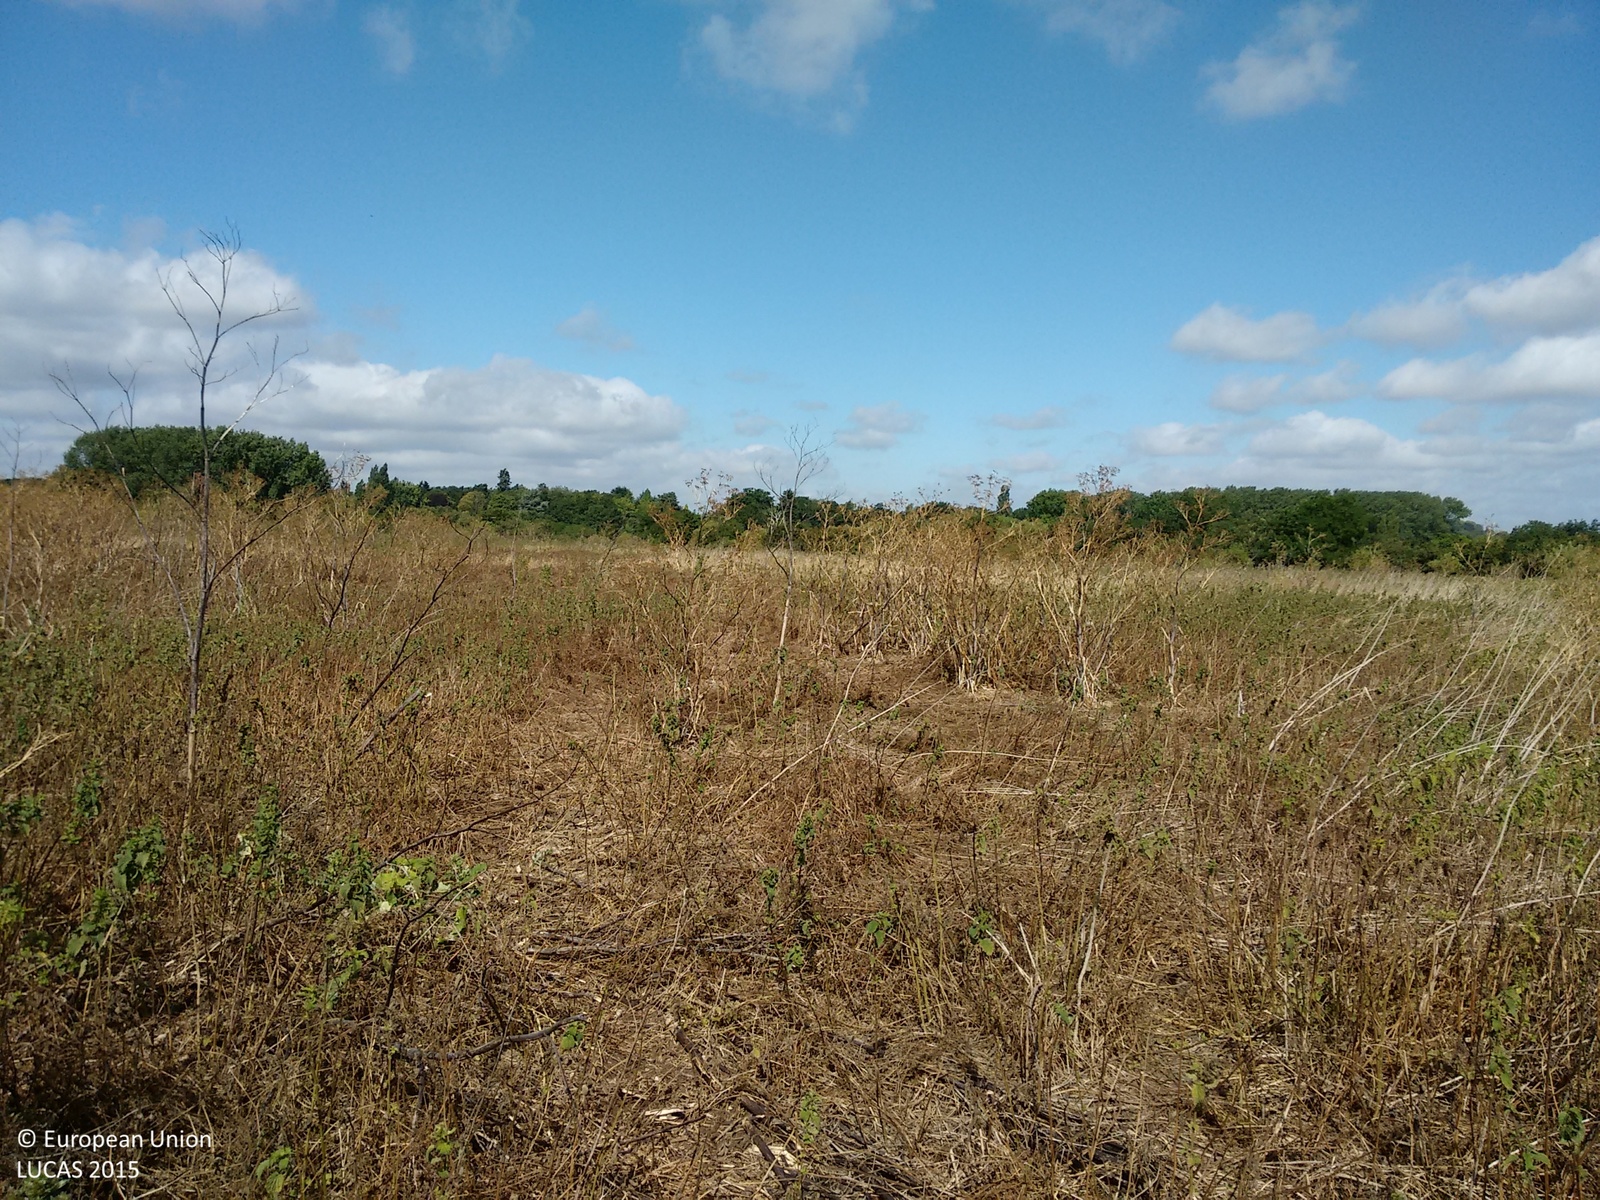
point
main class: Shrubland
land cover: Shrubland without tree cover
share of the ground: > 75 %
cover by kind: shrubs 50 %, herbaceous plants 40 %, consolidated bare surface 10 %
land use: Fallow land
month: July
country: GB
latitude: 51.3986
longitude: -0.5460
